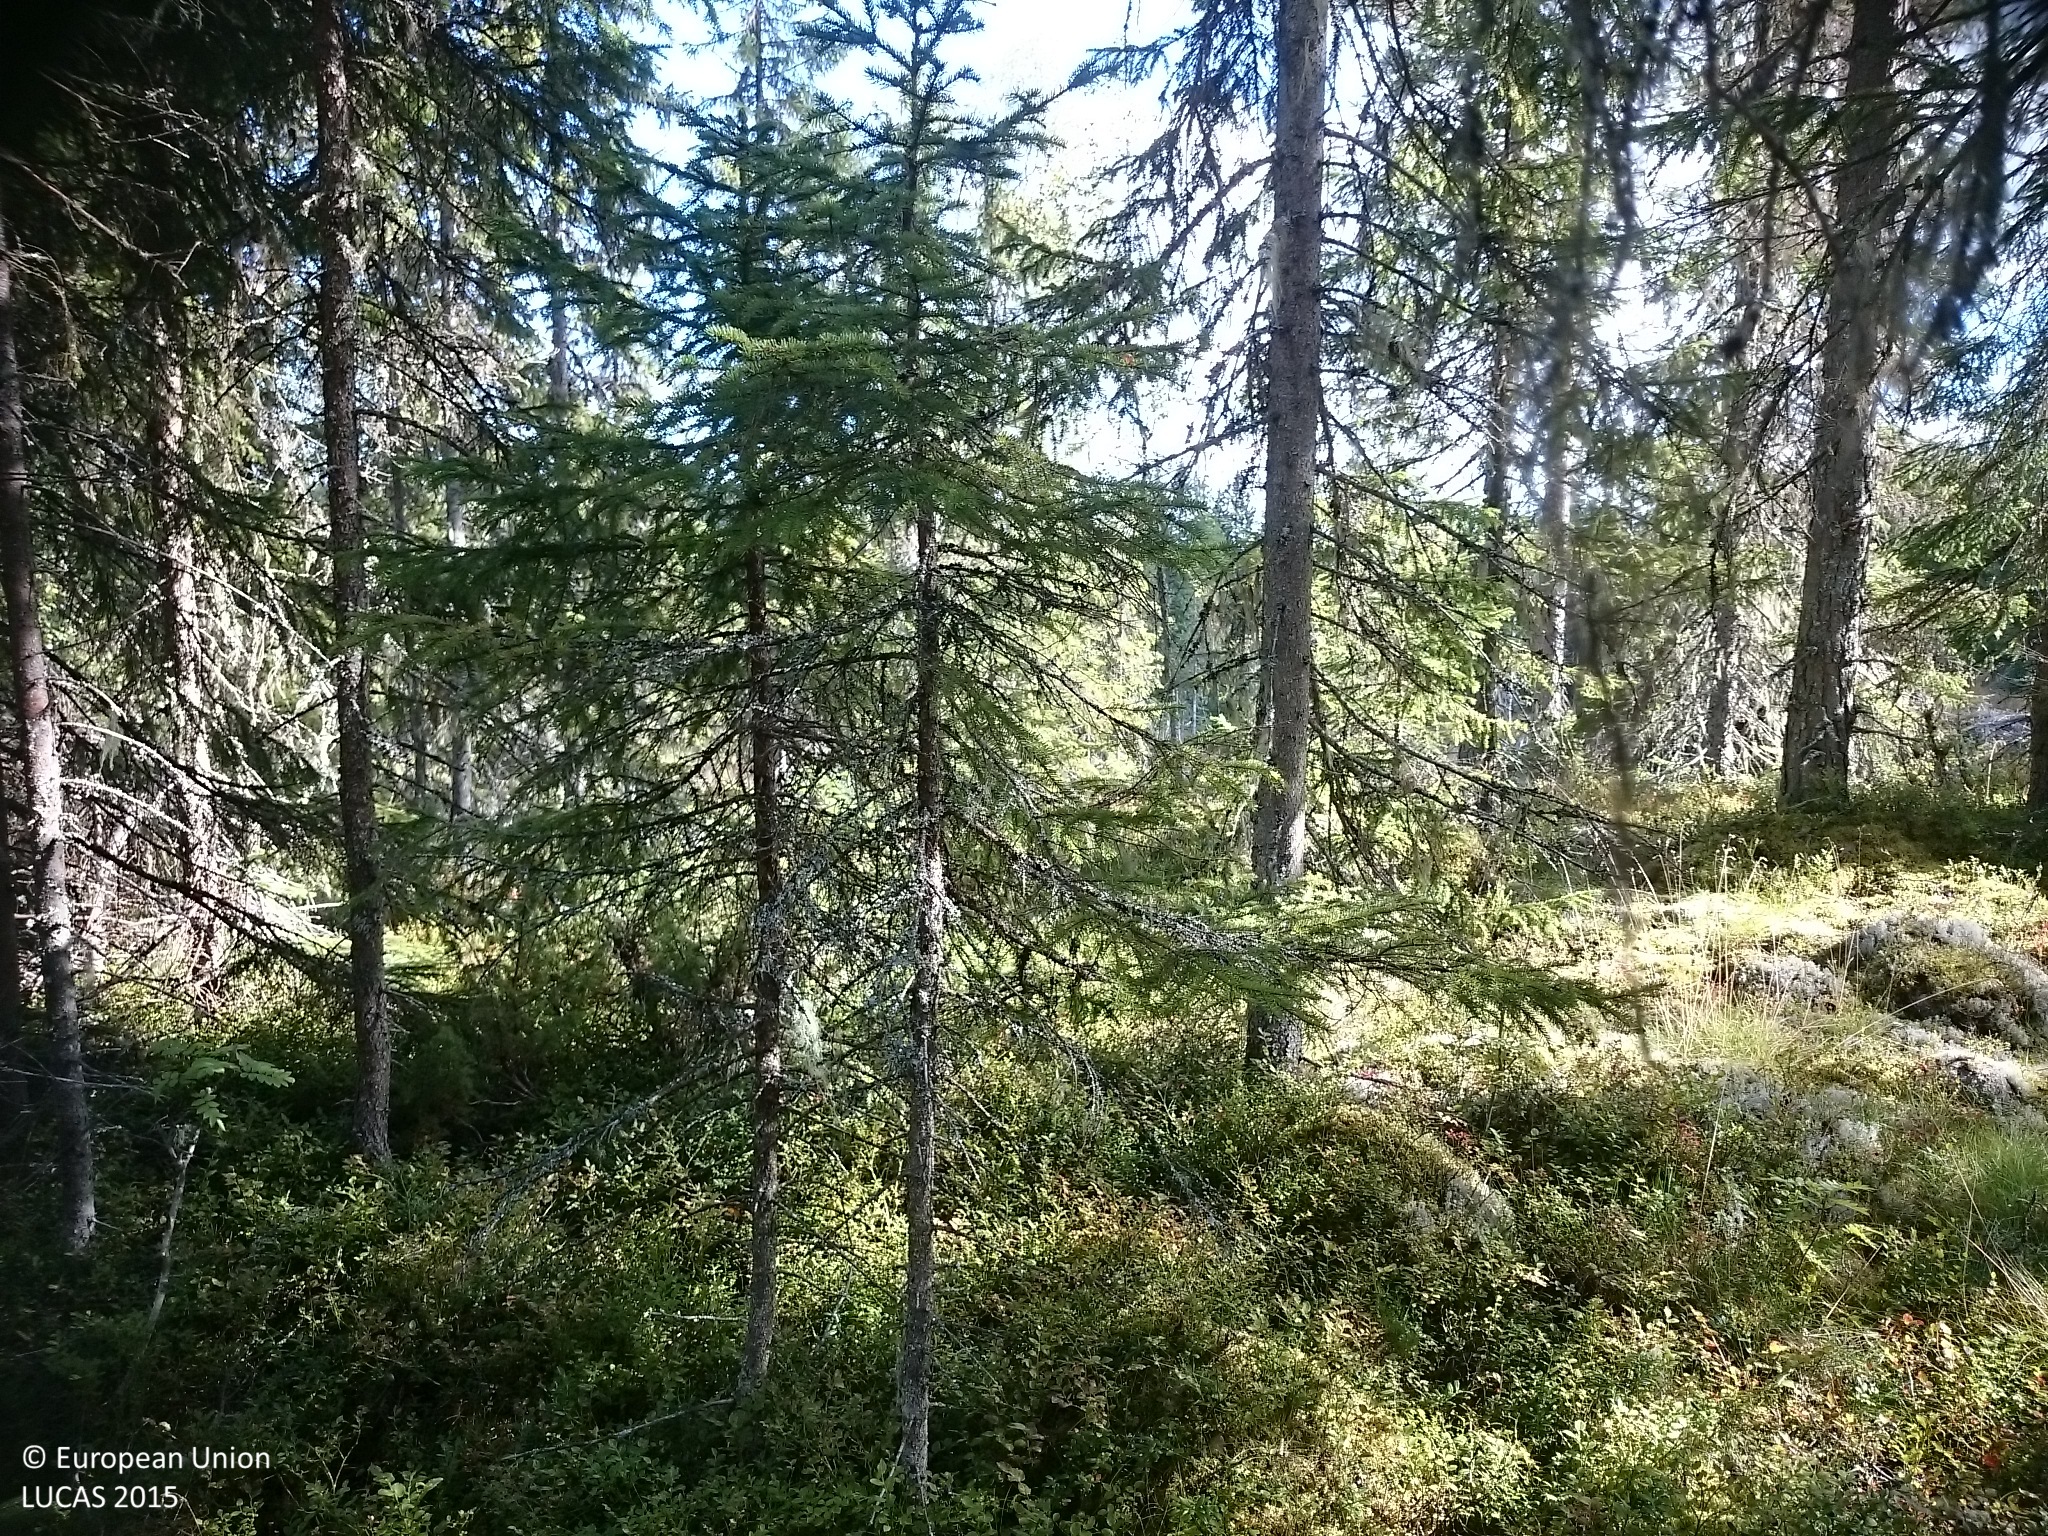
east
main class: Woodland
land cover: Spruce dominated coniferous woodland
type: boreal forest
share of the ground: 25 - 50 %
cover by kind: coniferous forest trees 50 %, shrubs 50 %
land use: Forestry
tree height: > 5 m
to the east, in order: Spruce dominated coniferous woodland; Broadleaved woodland; Shrubland with sparse tree cover; Other mixed woodland; Grass margins; Paved roads, cycling and walking lanes
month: September
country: SE
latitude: 62.4184
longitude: 16.8912
